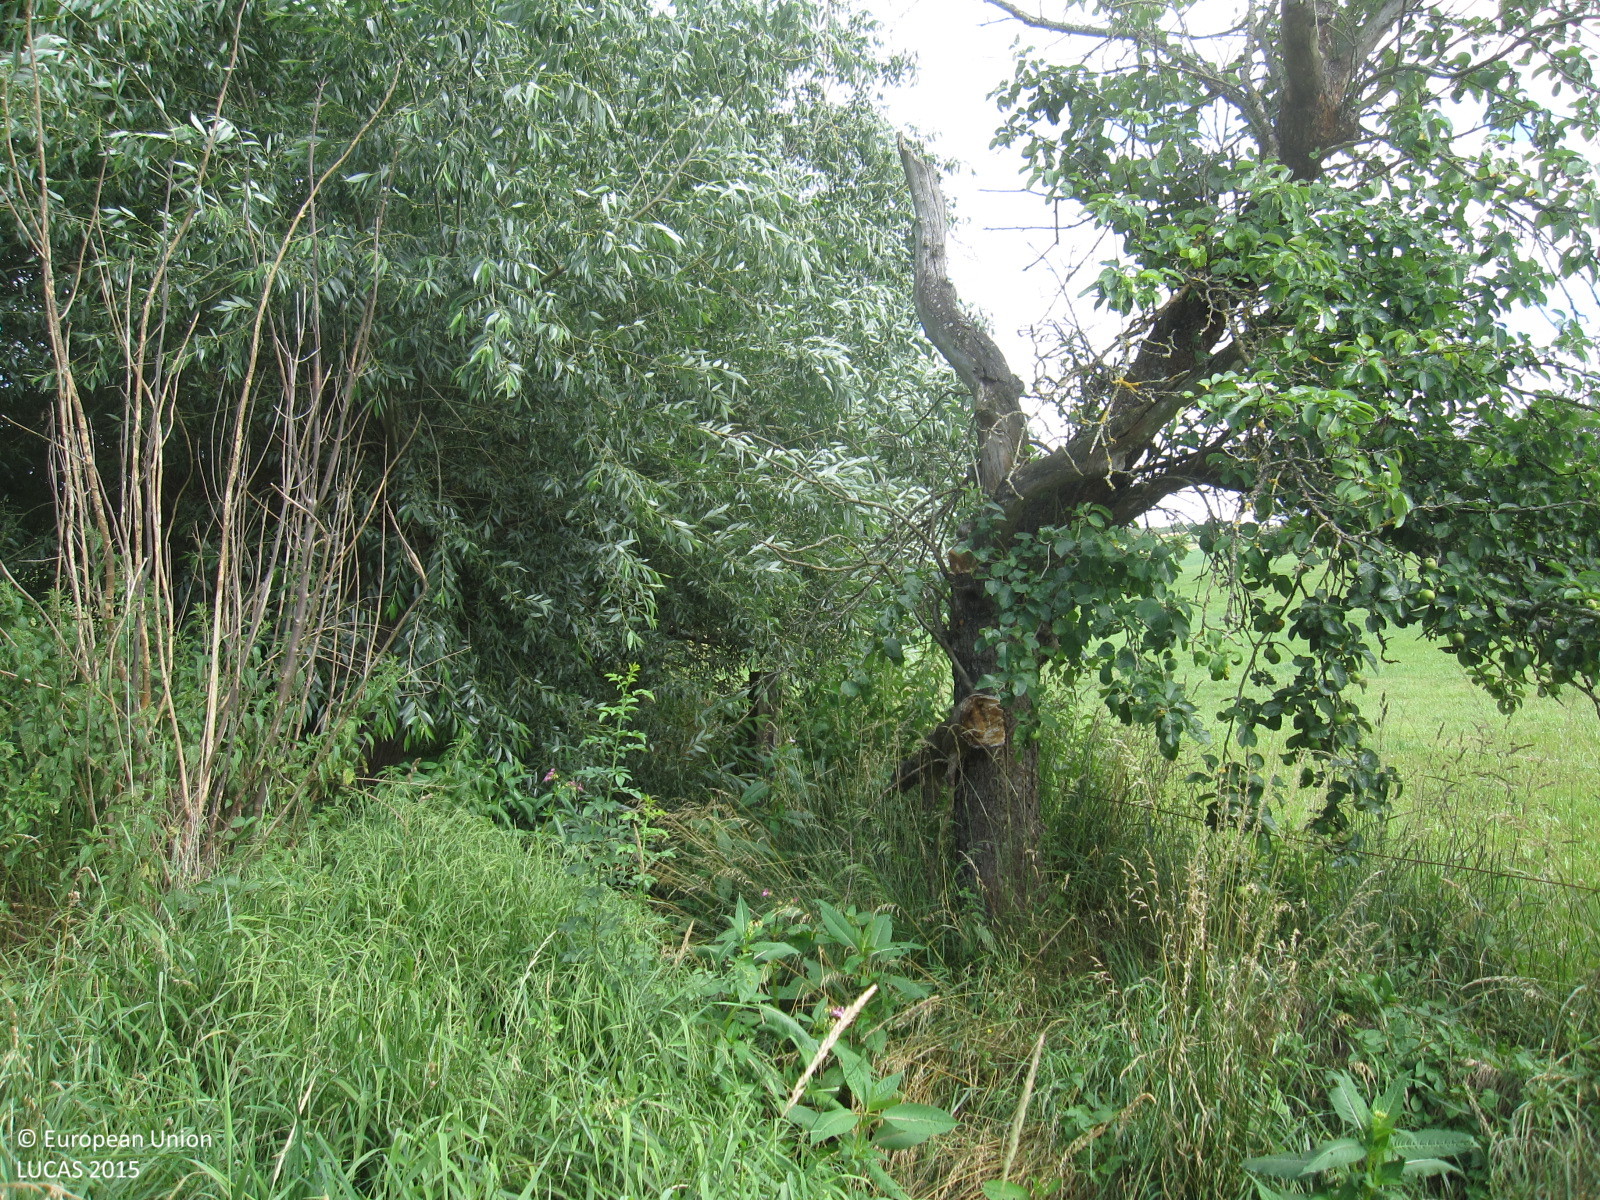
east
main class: Cropland
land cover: Cherry fruit
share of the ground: 50 - 75 %
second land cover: Grassland without tree/shrub cover
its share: > 75 %
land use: Agriculture (excluding fallow land and kitchen gardens)
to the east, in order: Cherry fruit; Grassland without tree/shrub cover; Tracks; Grassland without tree/shrub cover; Broadleaved woodland; Grassland without tree/shrub cover
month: July
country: DE
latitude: 50.9580
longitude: 12.0070
